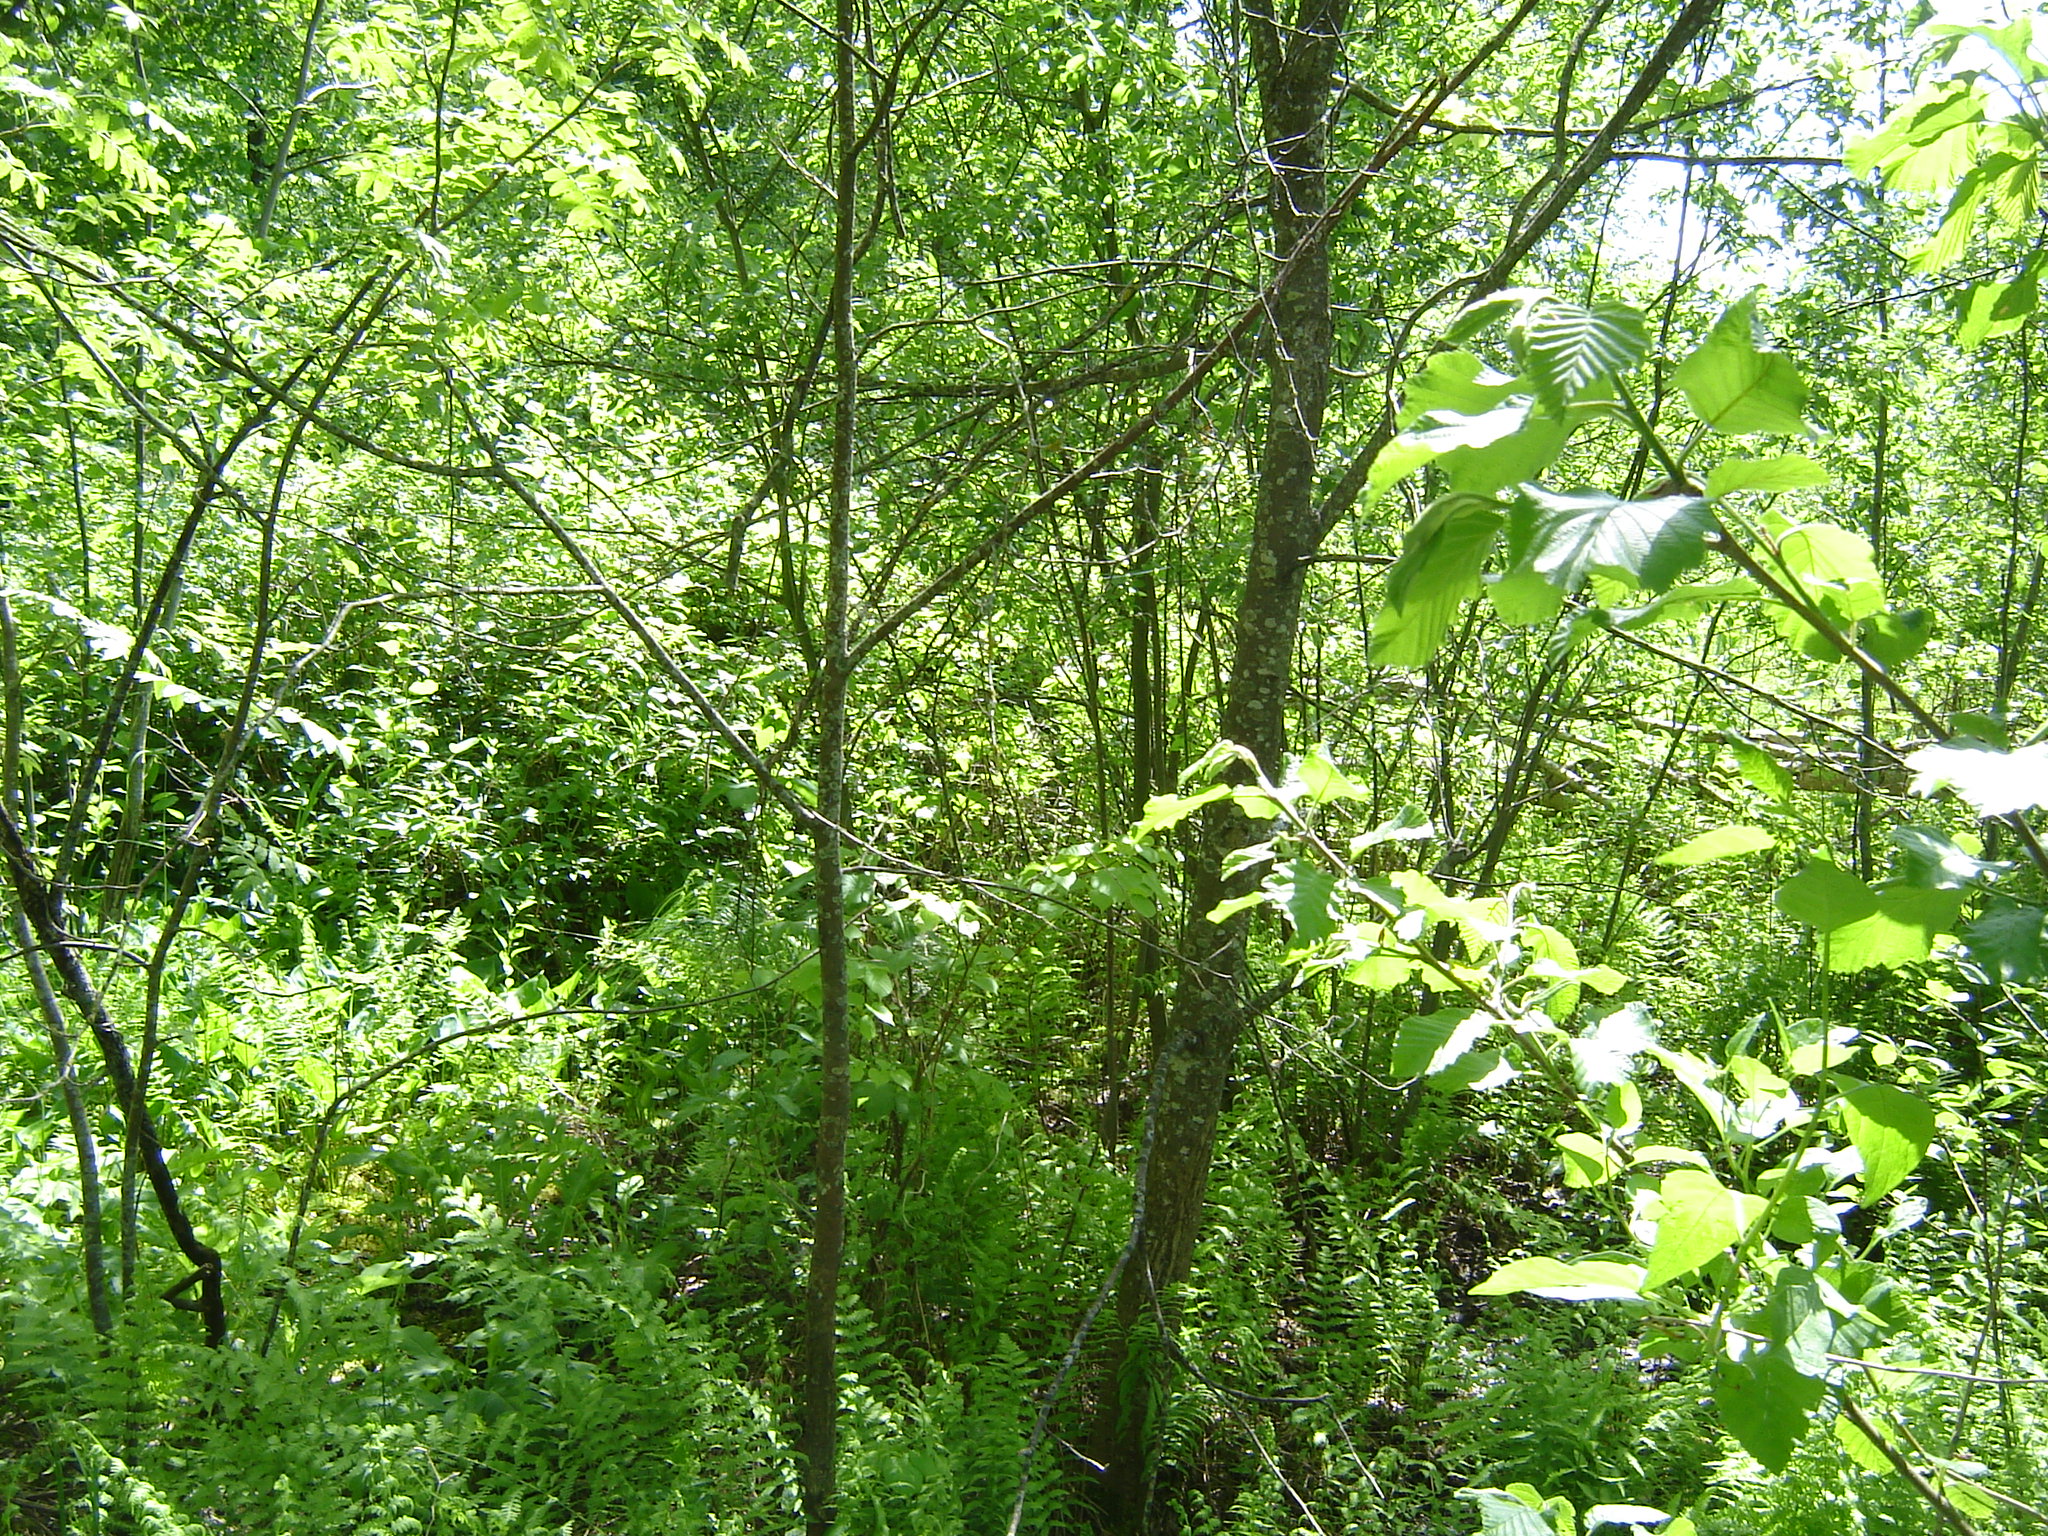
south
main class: Woodland
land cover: Broadleaved woodland
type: floodplain forest
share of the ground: > 75 %
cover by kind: broadleaved forest trees 80 %, herbaceous plants 20 %
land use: Semi-natural and natural areas not in use
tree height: > 5 m
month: June
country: LT
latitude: 55.5475
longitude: 25.5148
